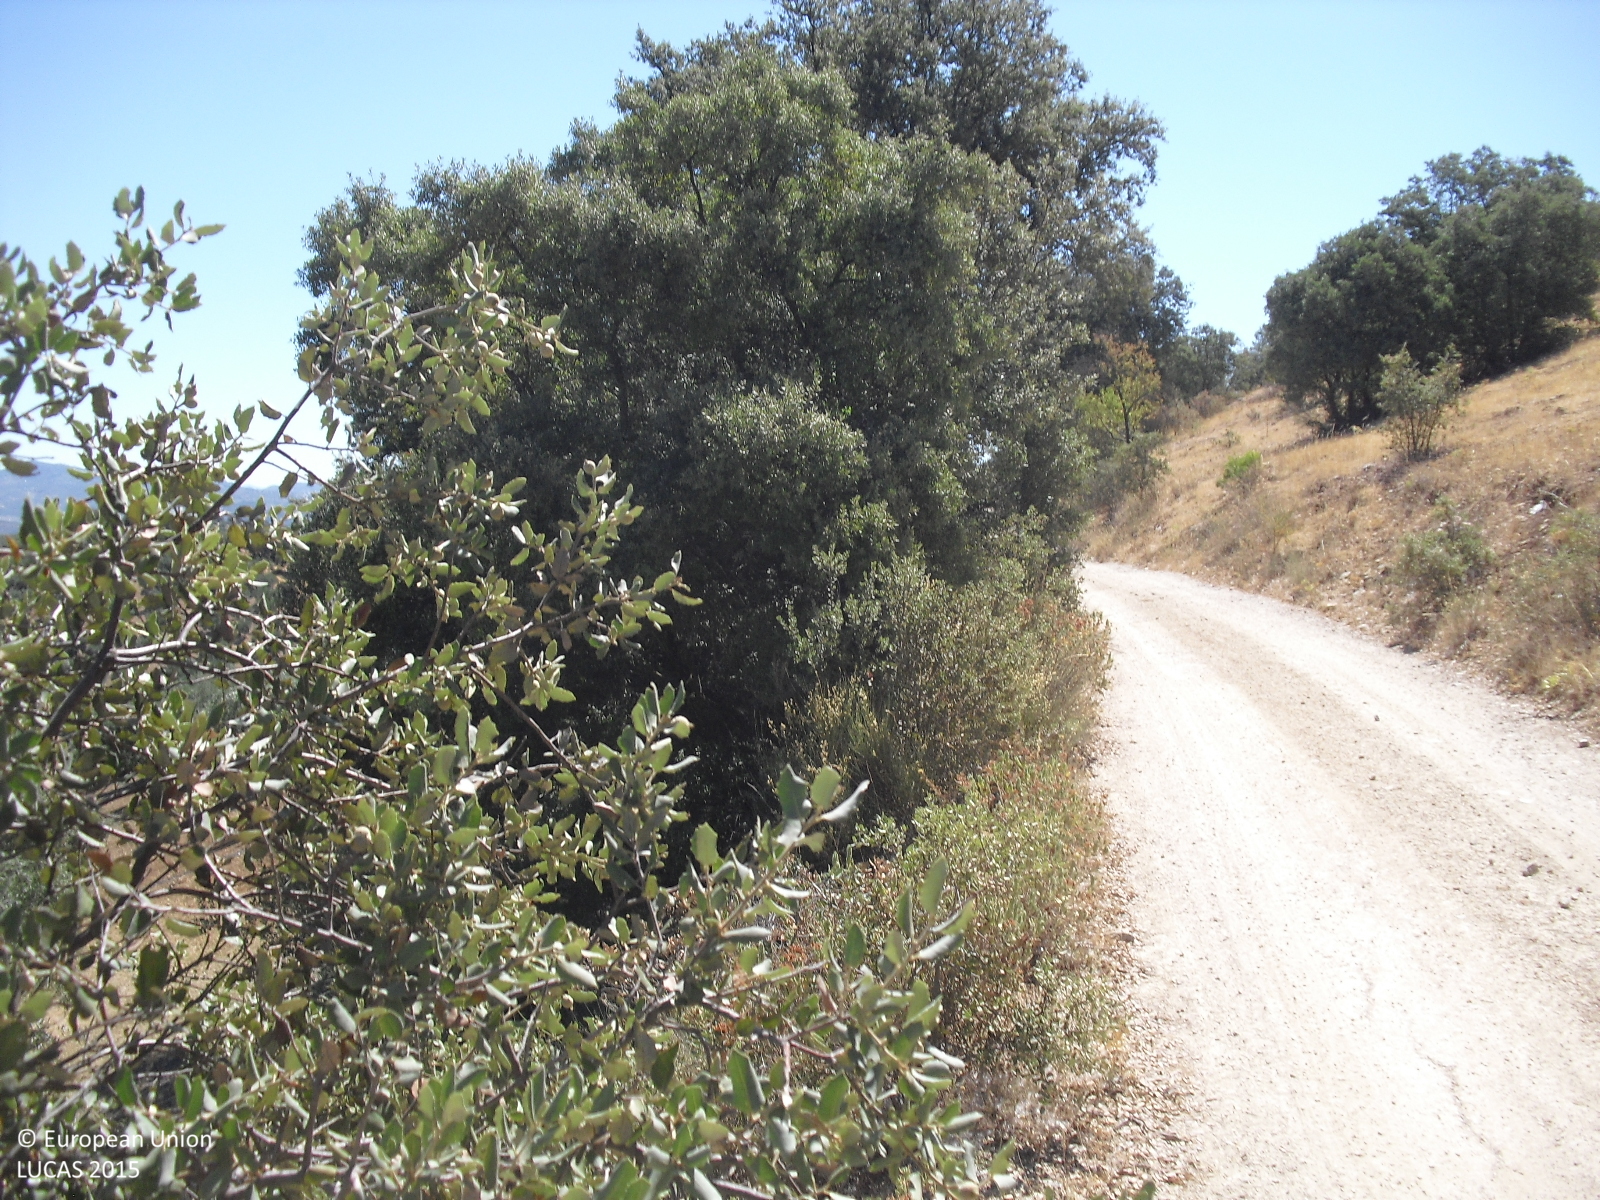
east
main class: Cropland
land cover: Olive groves
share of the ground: 25 - 50 %
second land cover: Other bare soil
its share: > 75 %
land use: Agriculture (excluding fallow land and kitchen gardens)
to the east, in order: Lines of trees; Olive groves; Broadleaved woodland
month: August
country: ES
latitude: 37.2964
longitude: -4.1088
